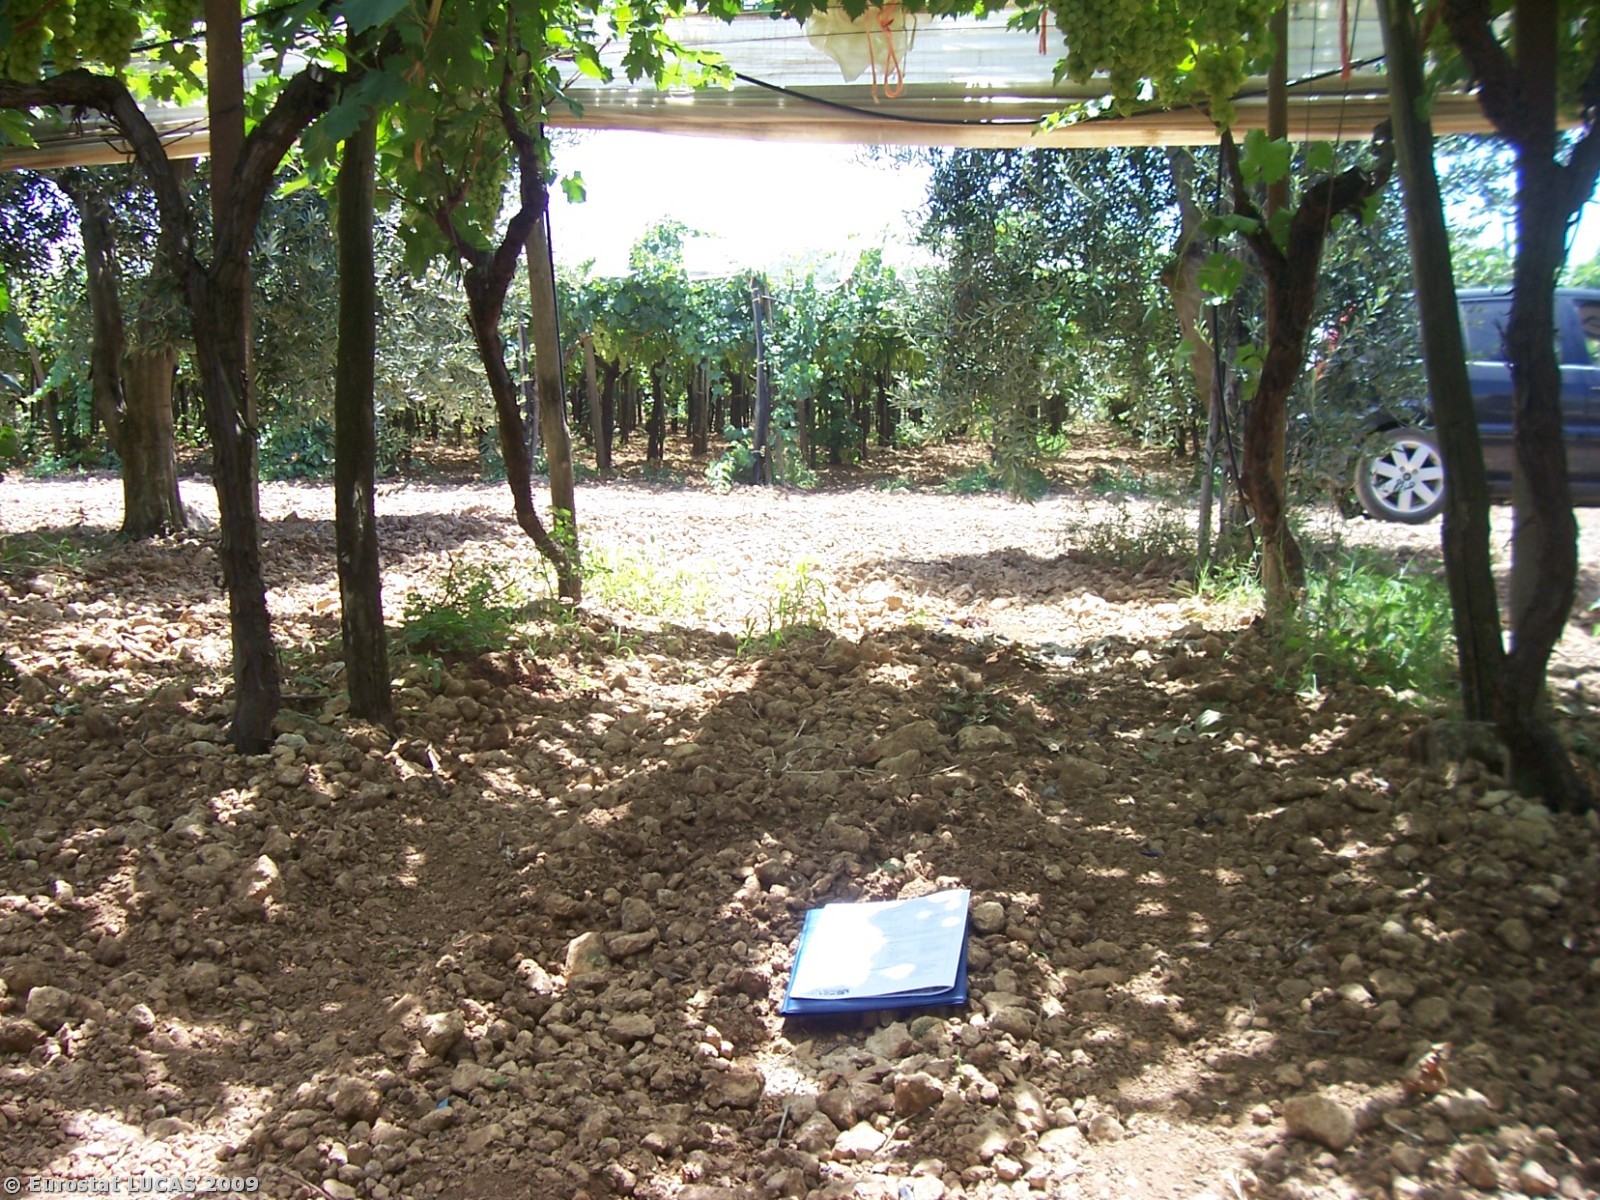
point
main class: Cropland
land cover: Vineyards
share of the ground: > 75 %
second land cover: Bare land
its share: > 75 %
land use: Agriculture (excluding fallow land and kitchen gardens)
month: July
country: IT
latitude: 40.6155
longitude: 17.0094
